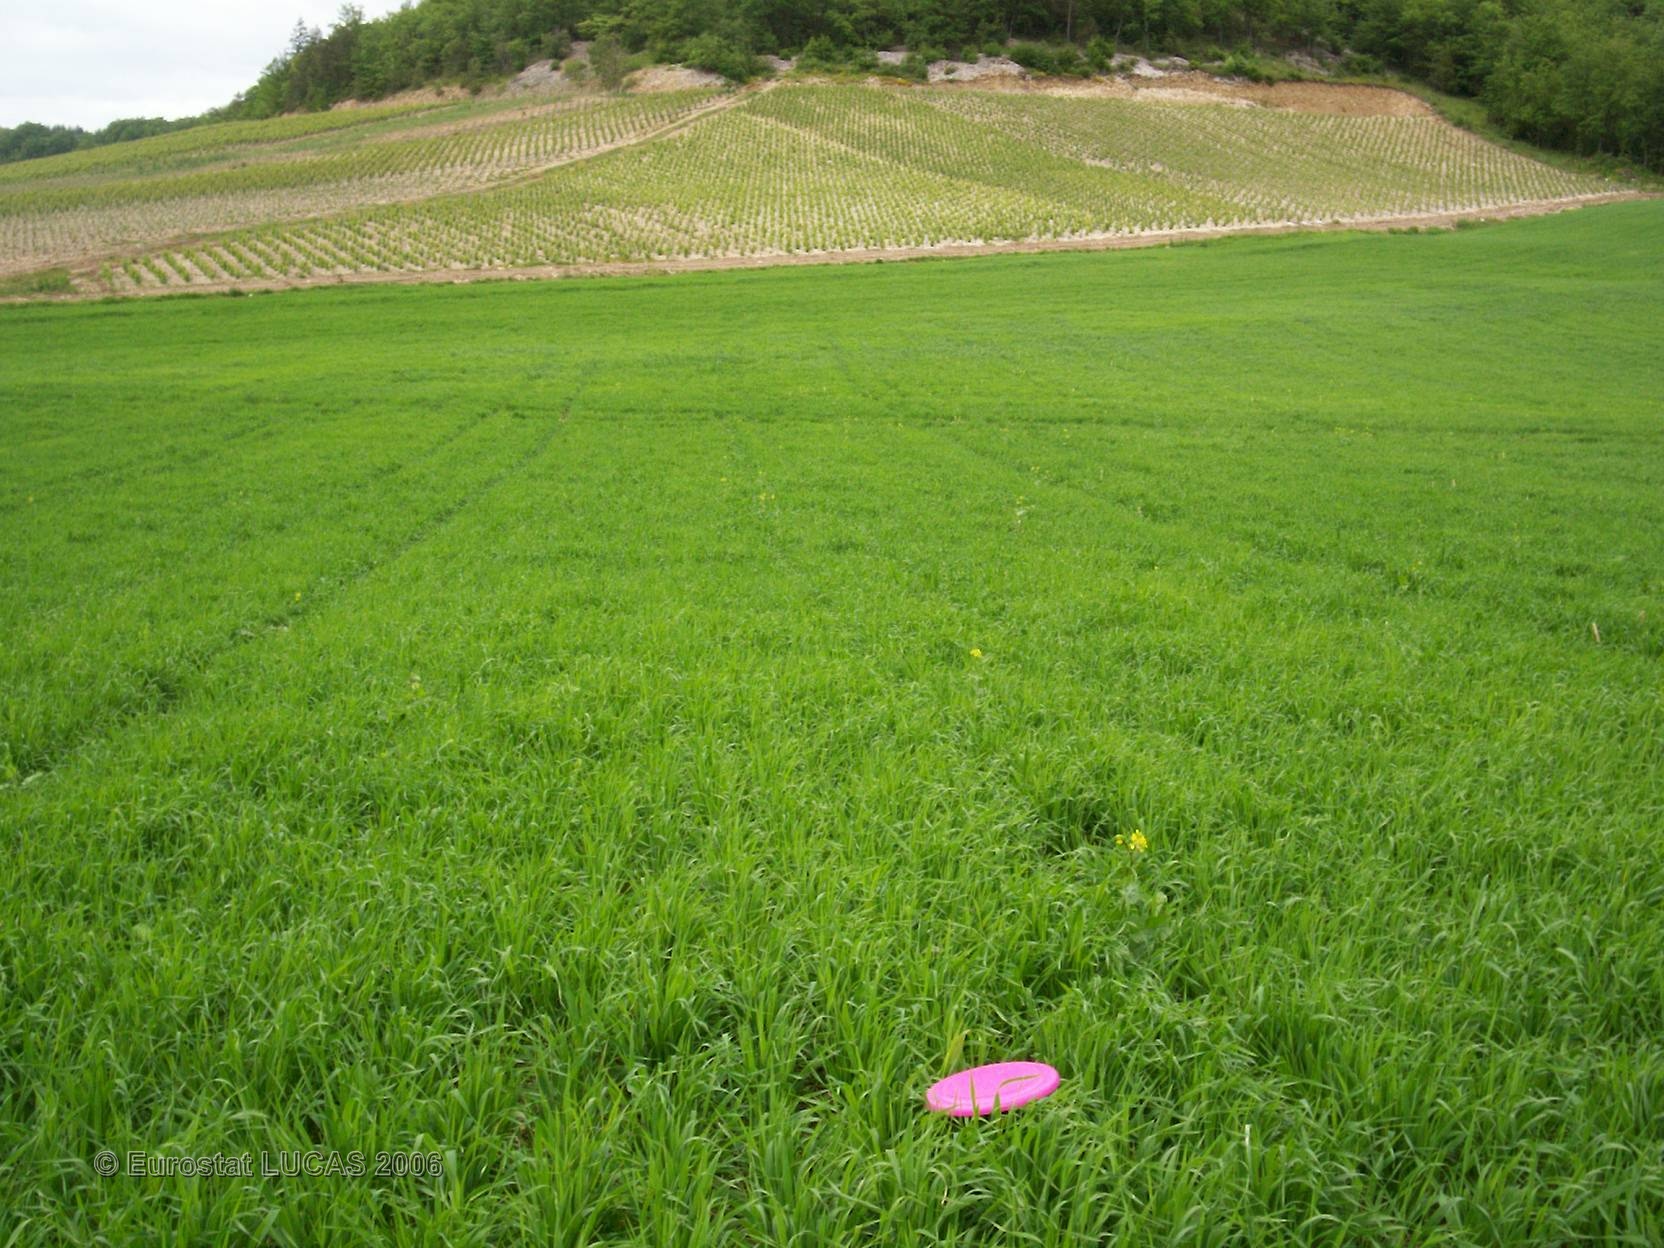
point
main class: Cropland
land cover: Barley
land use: Agriculture (excluding fallow land and kitchen gardens)
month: May
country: FR
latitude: 48.2035
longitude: 4.6832
